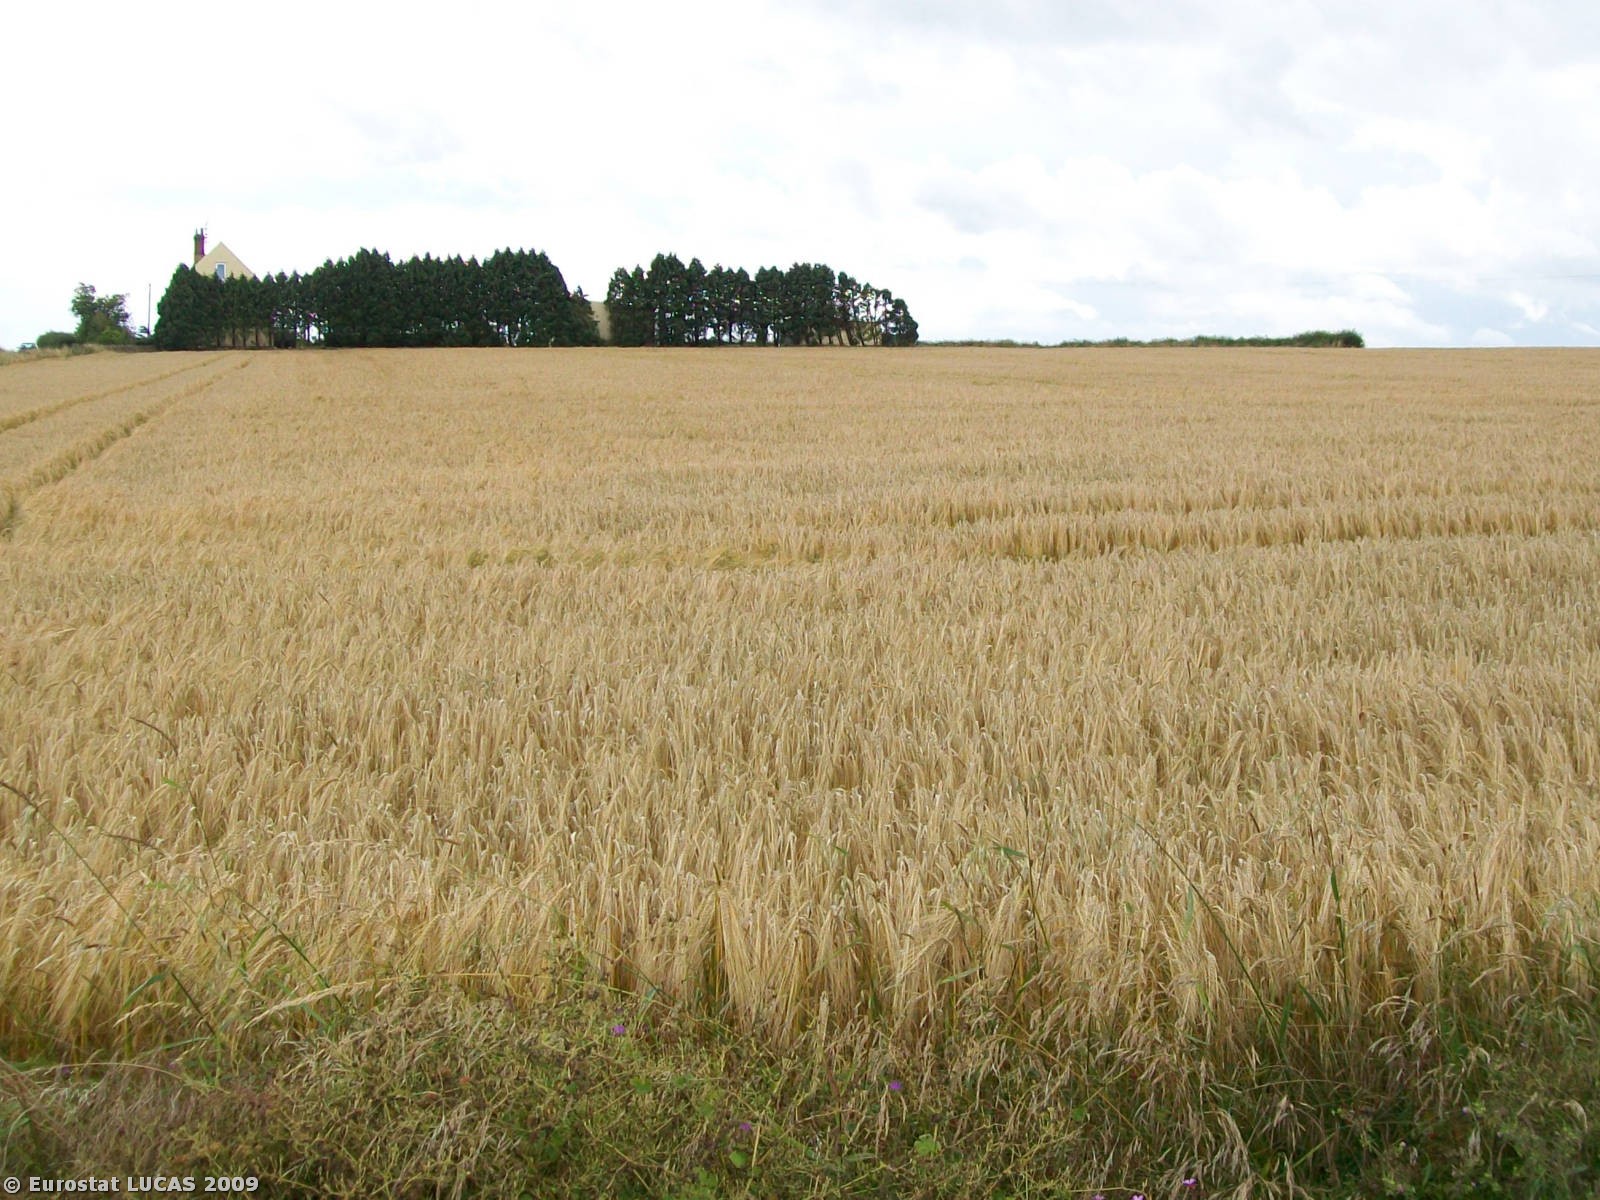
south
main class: Cropland
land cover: Barley
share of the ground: > 75 %
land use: Agriculture (excluding fallow land and kitchen gardens)
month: July
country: GB
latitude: 51.4783
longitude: -2.3167
